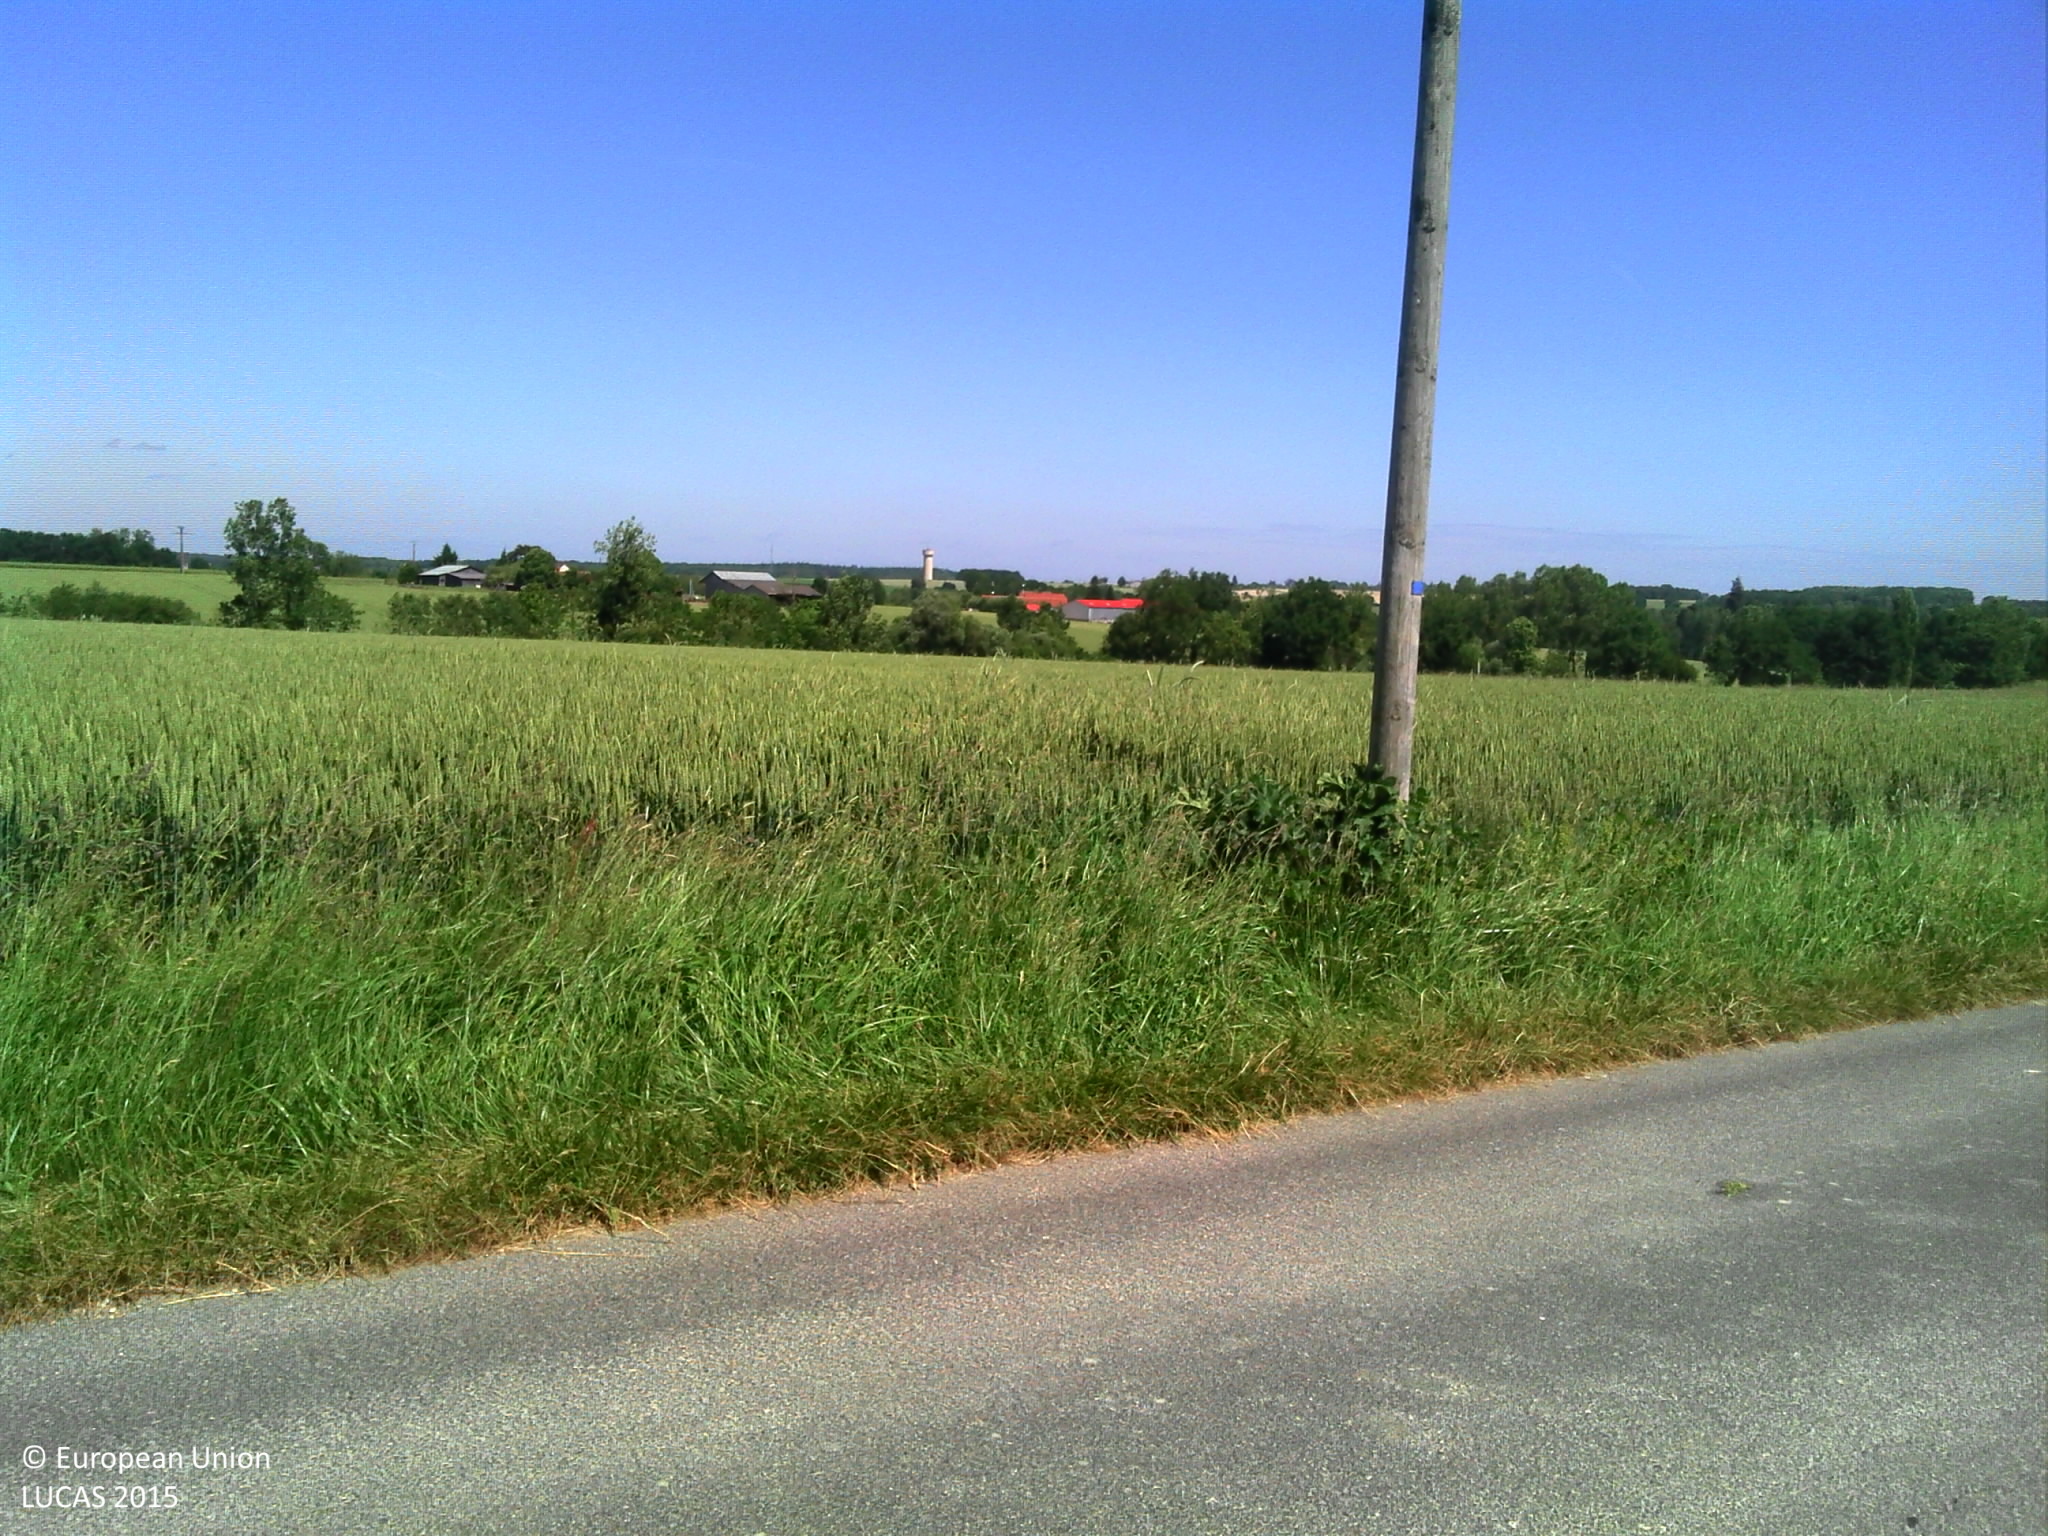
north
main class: Cropland
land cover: Common wheat
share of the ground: > 75 %
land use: Agriculture (excluding fallow land and kitchen gardens)
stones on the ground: < 10 %
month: June
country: FR
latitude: 47.1304
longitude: 1.2187
